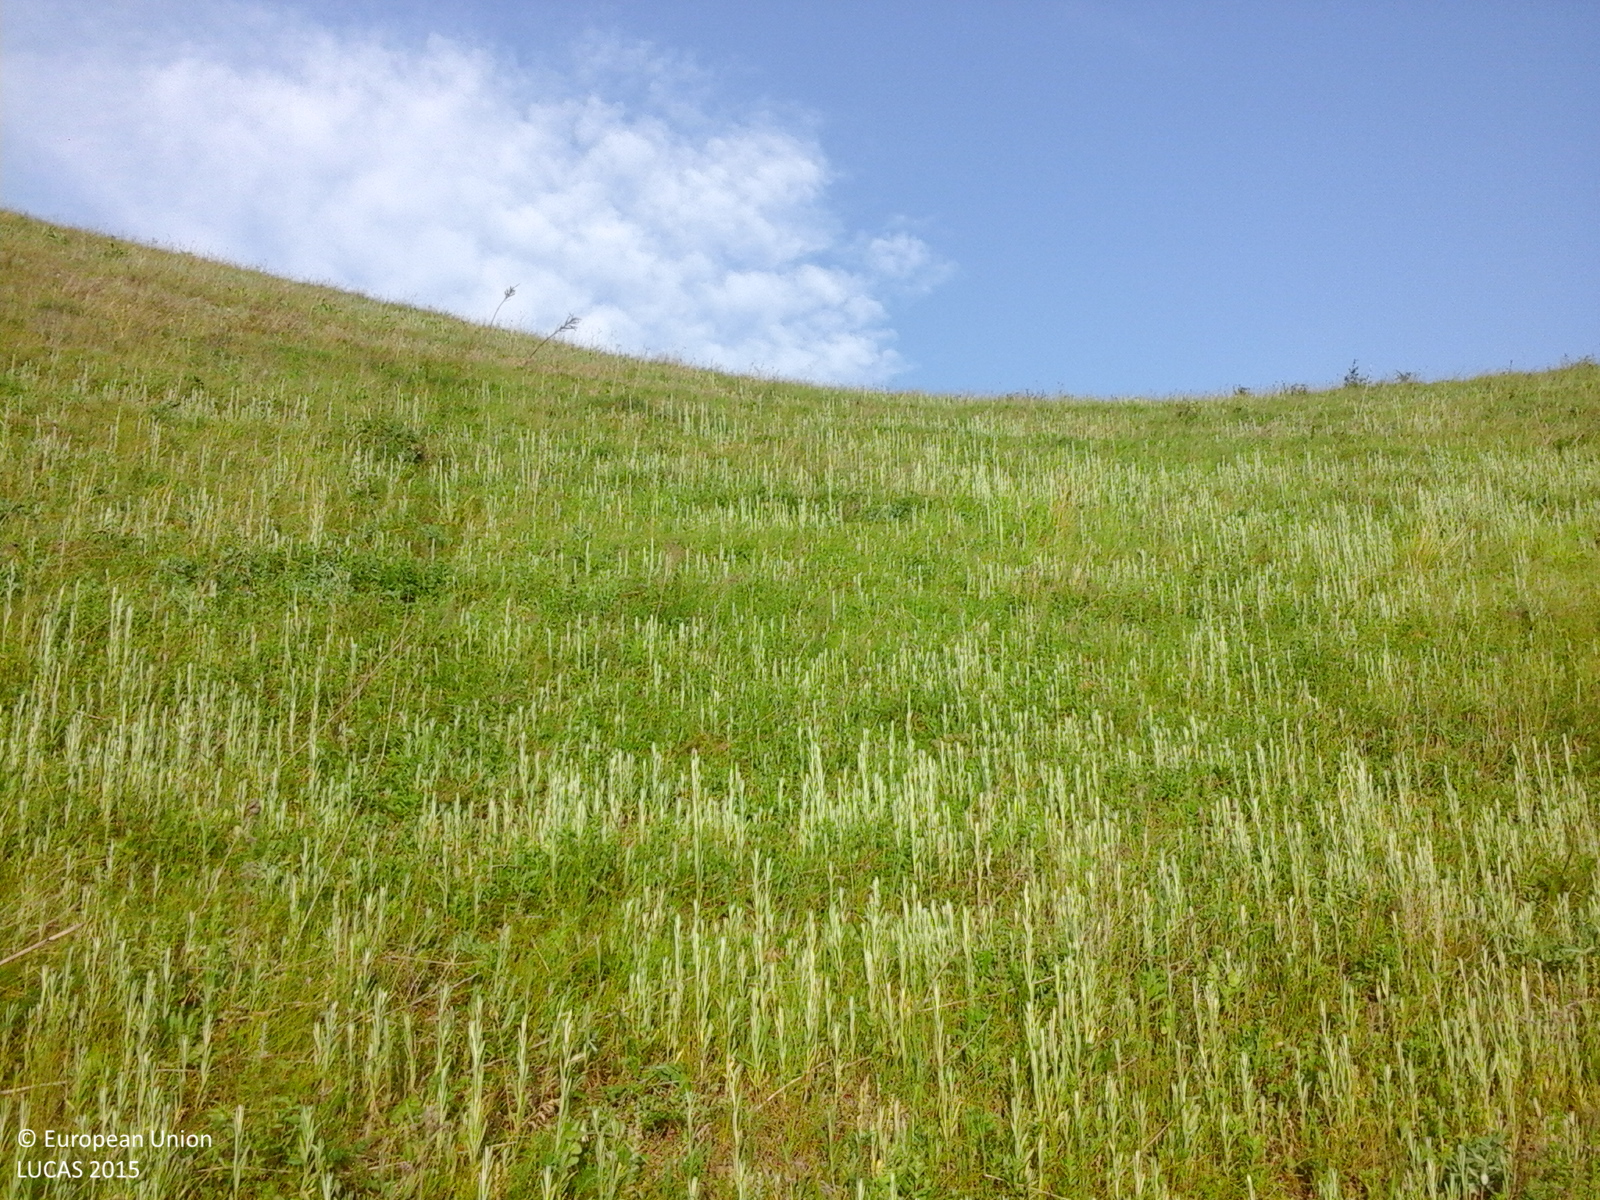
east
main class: Grassland
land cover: Grassland without tree/shrub cover
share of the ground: > 75 %
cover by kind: herbaceous plants 100 %
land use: Agriculture (excluding fallow land and kitchen gardens)
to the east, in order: Grassland without tree/shrub cover; Tracks; Grass margins; Maize
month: June
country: RO
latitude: 46.4221
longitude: 27.0510
